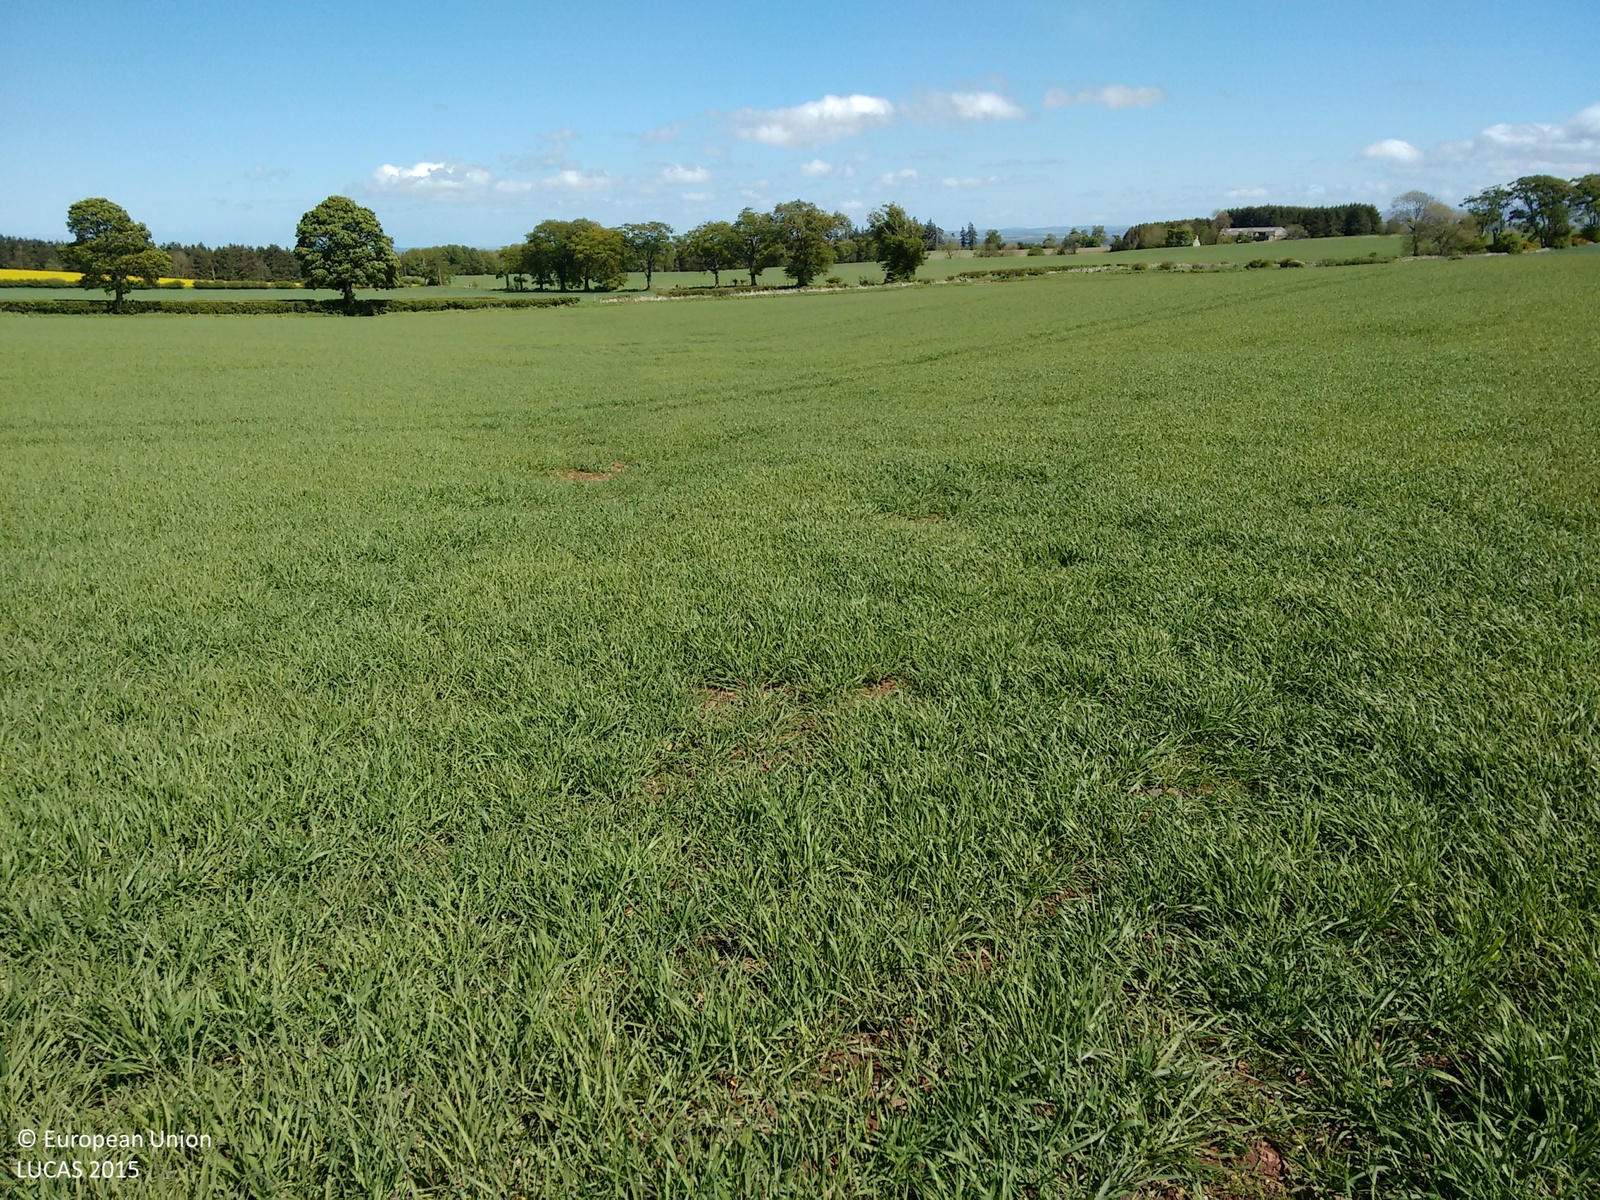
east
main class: Cropland
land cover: Barley
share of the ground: > 75 %
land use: Agriculture (excluding fallow land and kitchen gardens)
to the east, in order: Barley; Grass margins; Abandoned hedges; Grass margins; Paved roads, cycling and walking lanes; Grass margins; Abandoned hedges; Ditches and canals; Grass margins; Oats
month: June
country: GB
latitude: 55.6877
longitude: -2.4508
